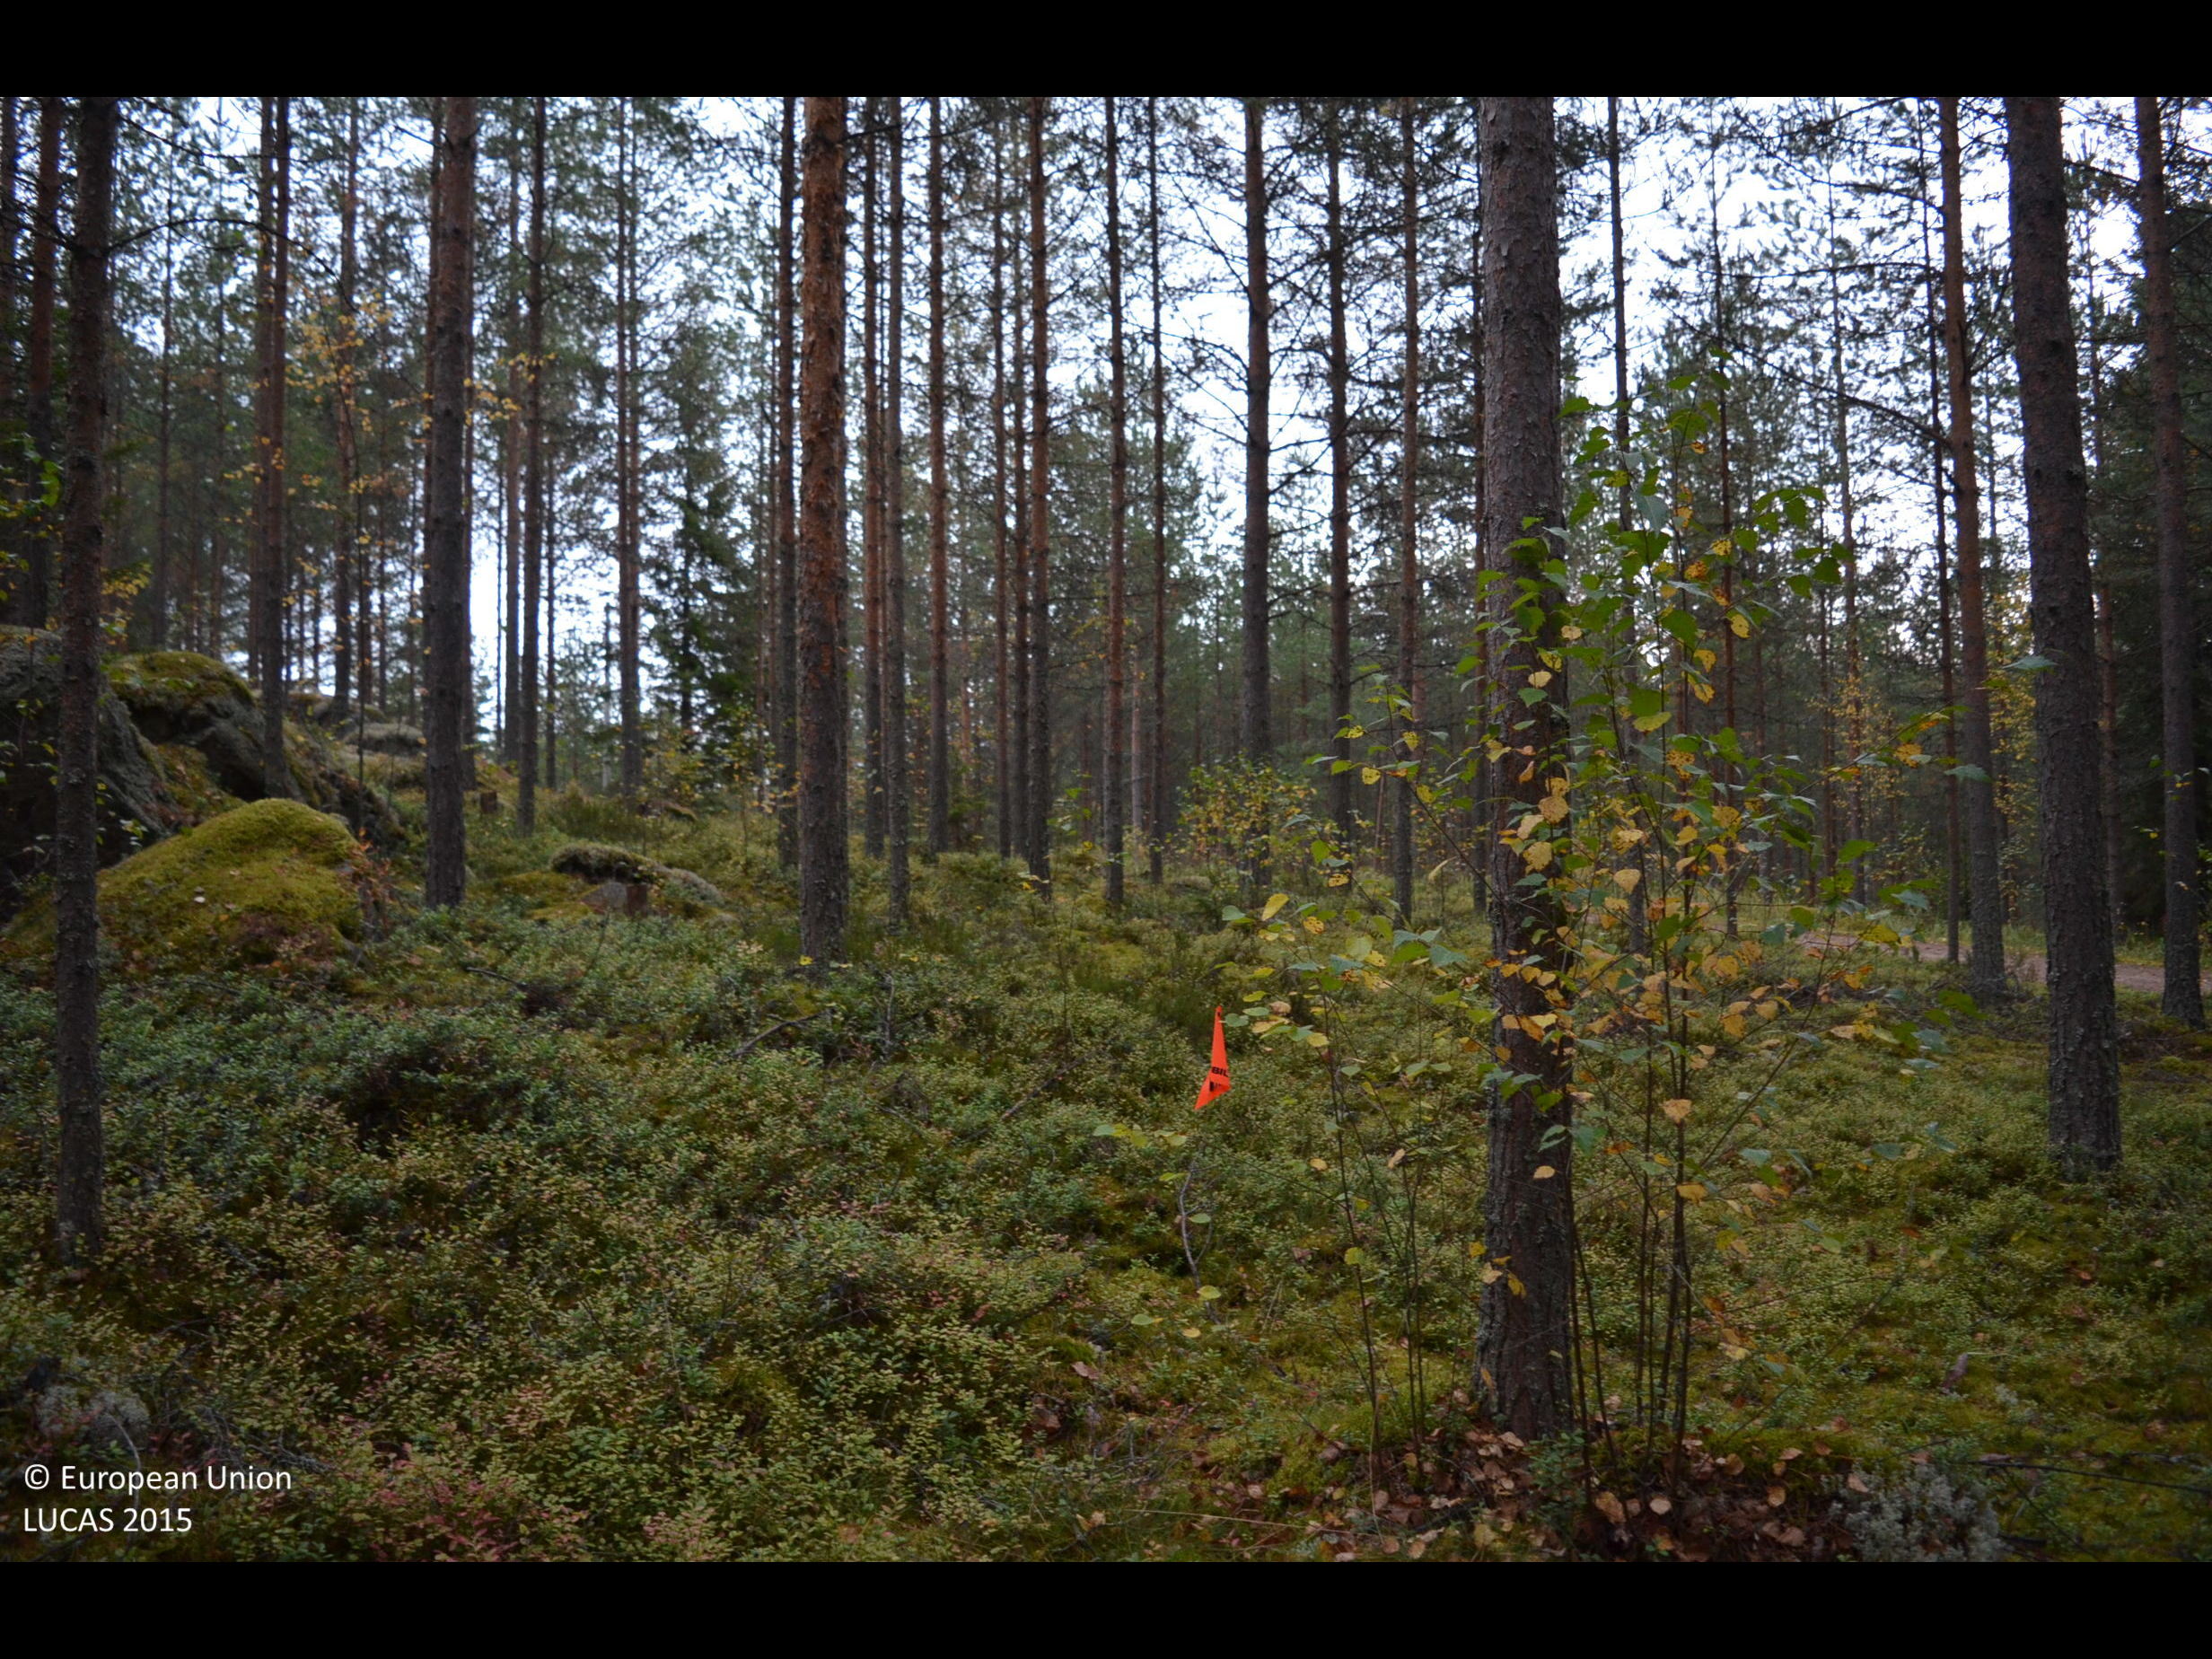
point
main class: Woodland
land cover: Pine dominated coniferous woodland
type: boreal forest
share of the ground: 50 - 75 %
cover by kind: coniferous forest trees 65 %, shrubs 25 %, broadleaved forest trees 5 %, lichens and mosses 5 %
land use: Forestry
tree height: > 5 m
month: September
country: FI
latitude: 62.5894
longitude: 23.6836
